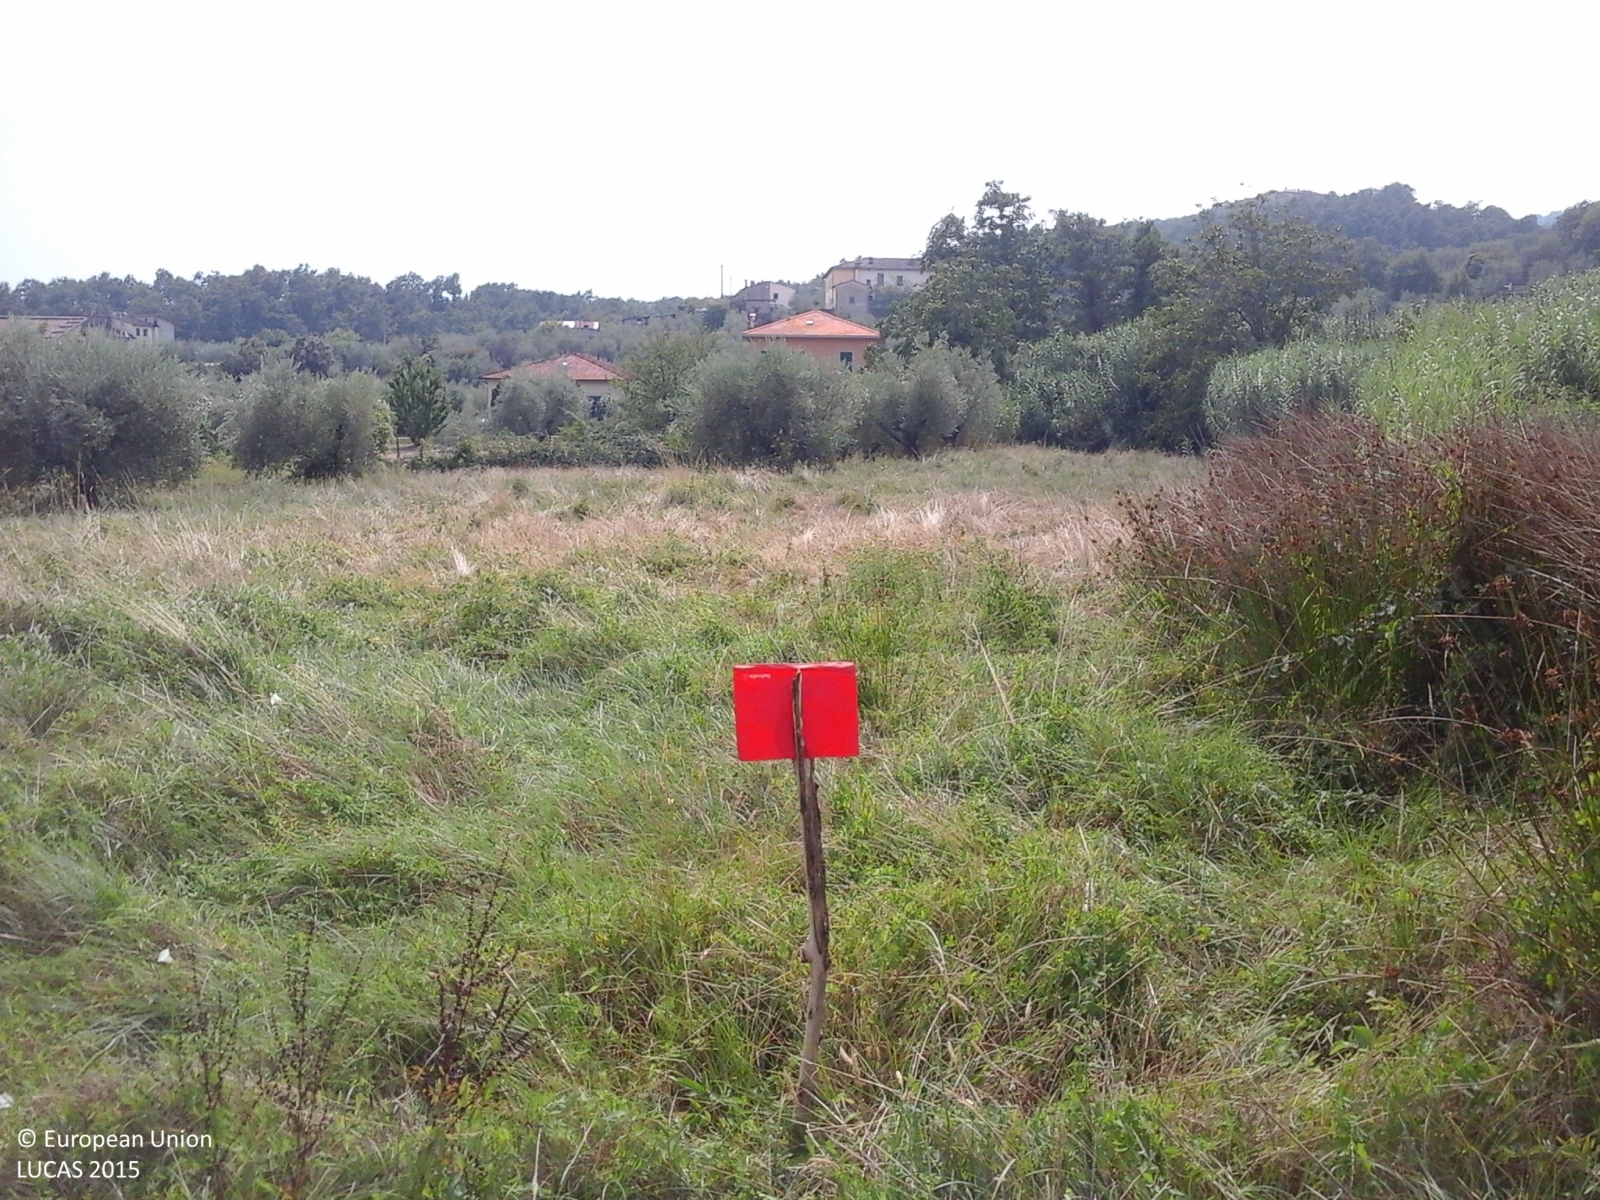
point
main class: Grassland
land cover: Spontaneously vegetated surfaces
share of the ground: > 75 %
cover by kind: herbaceous plants 100 %
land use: Semi-natural and natural areas not in use
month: August
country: IT
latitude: 43.9680
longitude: 10.8827
